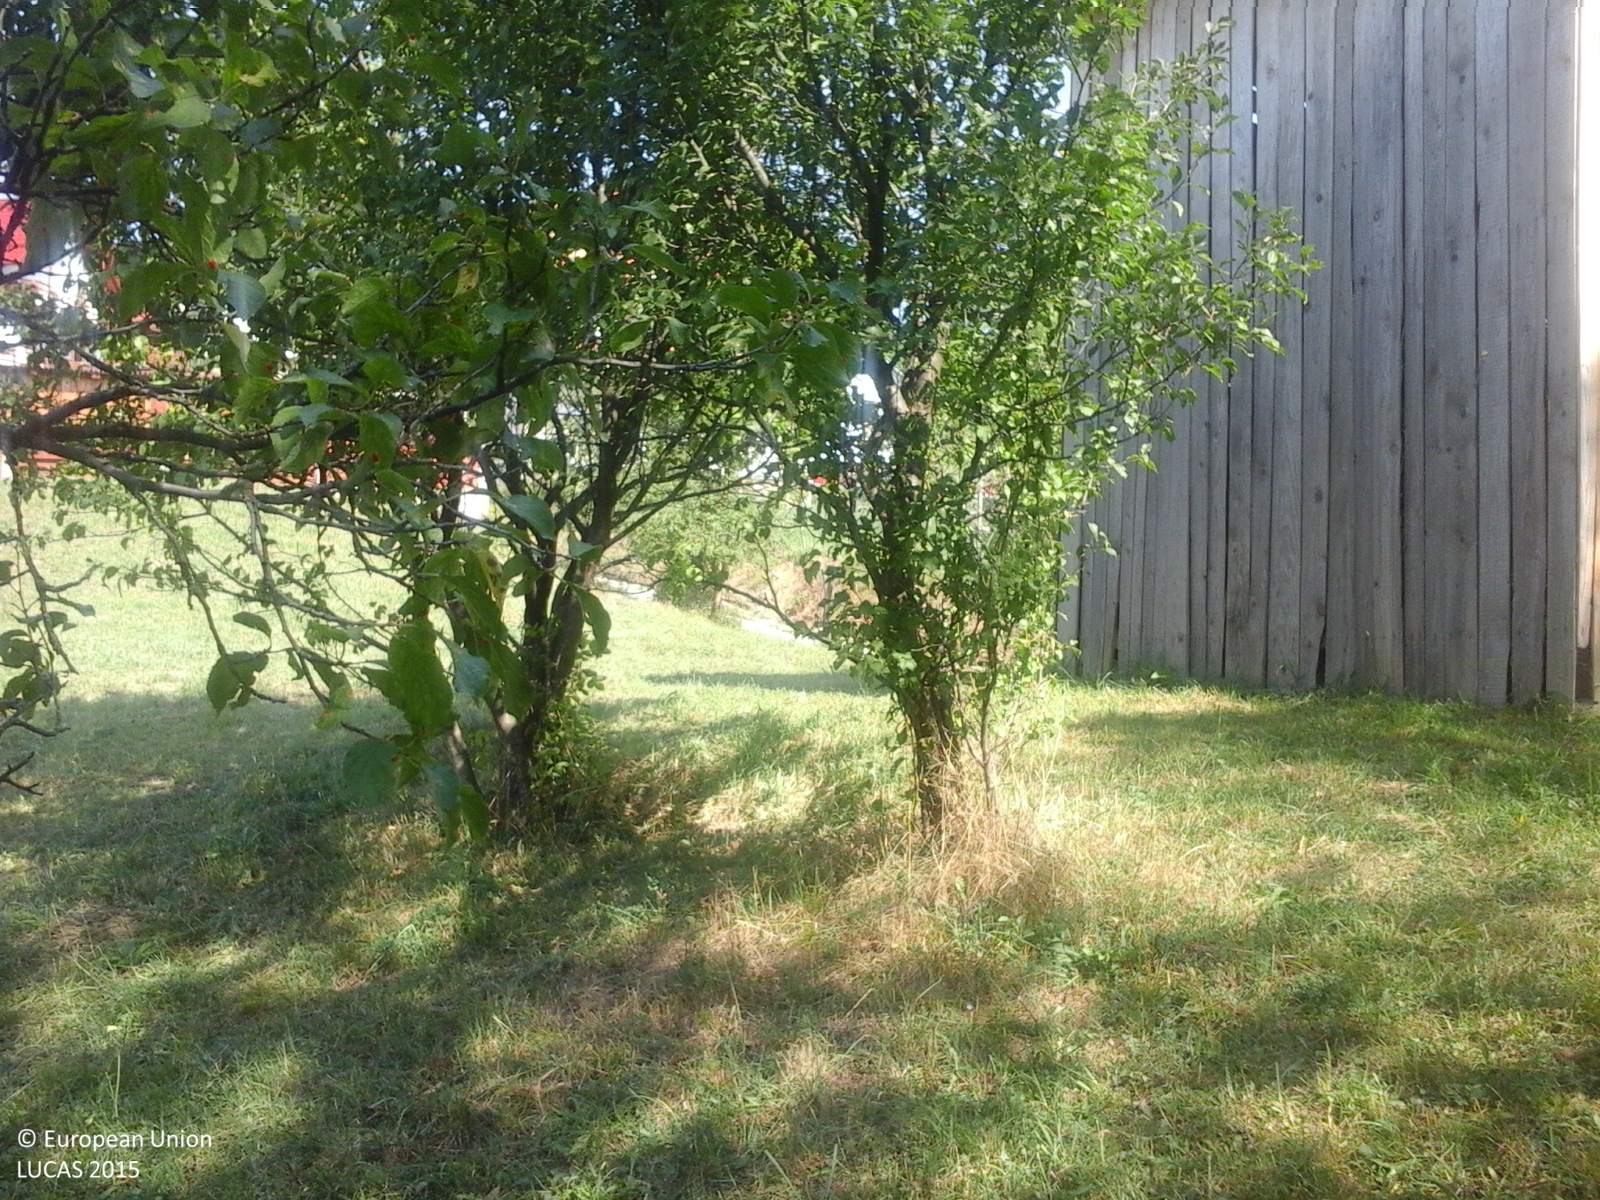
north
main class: Grassland
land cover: Grassland with sparse tree/shrub cover
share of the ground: > 75 %
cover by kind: herbaceous plants 85 %, shrubs 10 %, broadleaved forest trees 5 %
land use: Agriculture (excluding fallow land and kitchen gardens)
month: September
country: RO
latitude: 47.6620
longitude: 24.6250
